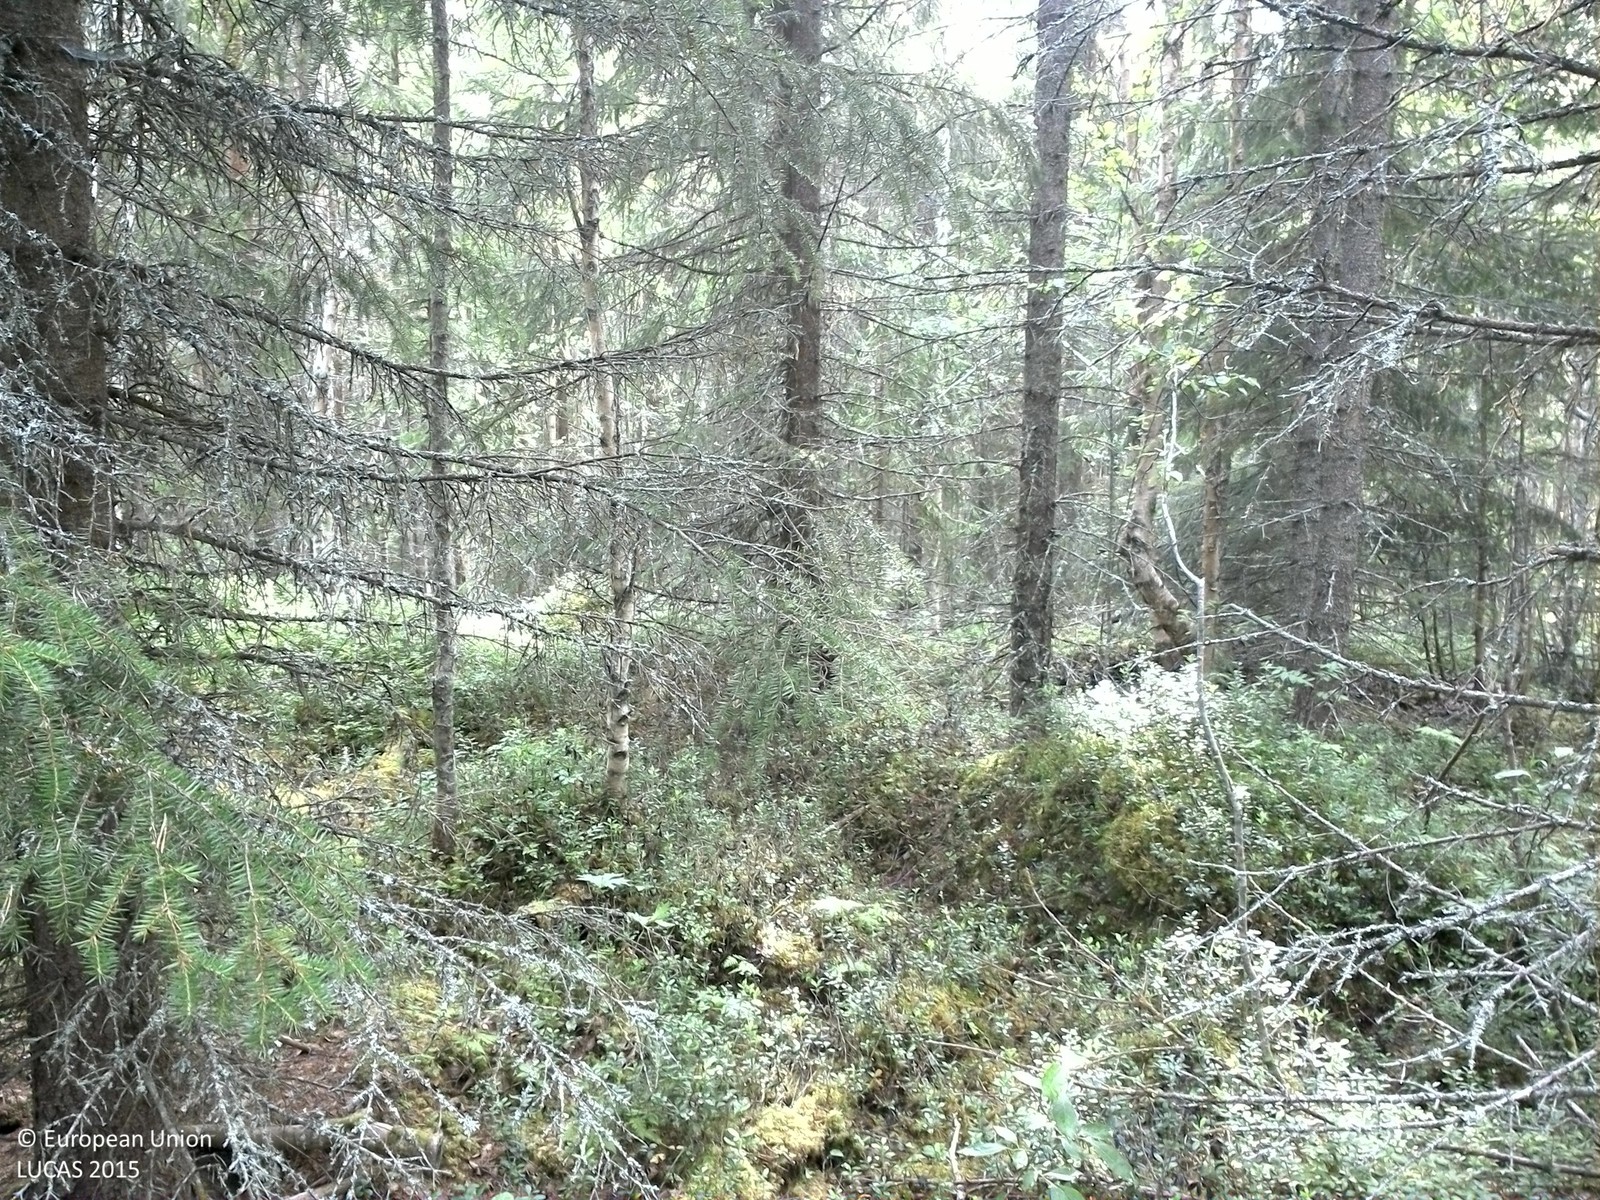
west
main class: Woodland
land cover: Spruce dominated mixed woodland
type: boreal forest
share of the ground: 50 - 75 %
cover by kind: coniferous forest trees 45 %, broadleaved forest trees 25 %, shrubs 10 %, herbaceous plants 10 %, lichens and mosses 10 %
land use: Forestry
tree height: > 5 m
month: August
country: SE
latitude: 63.5868
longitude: 16.6828
